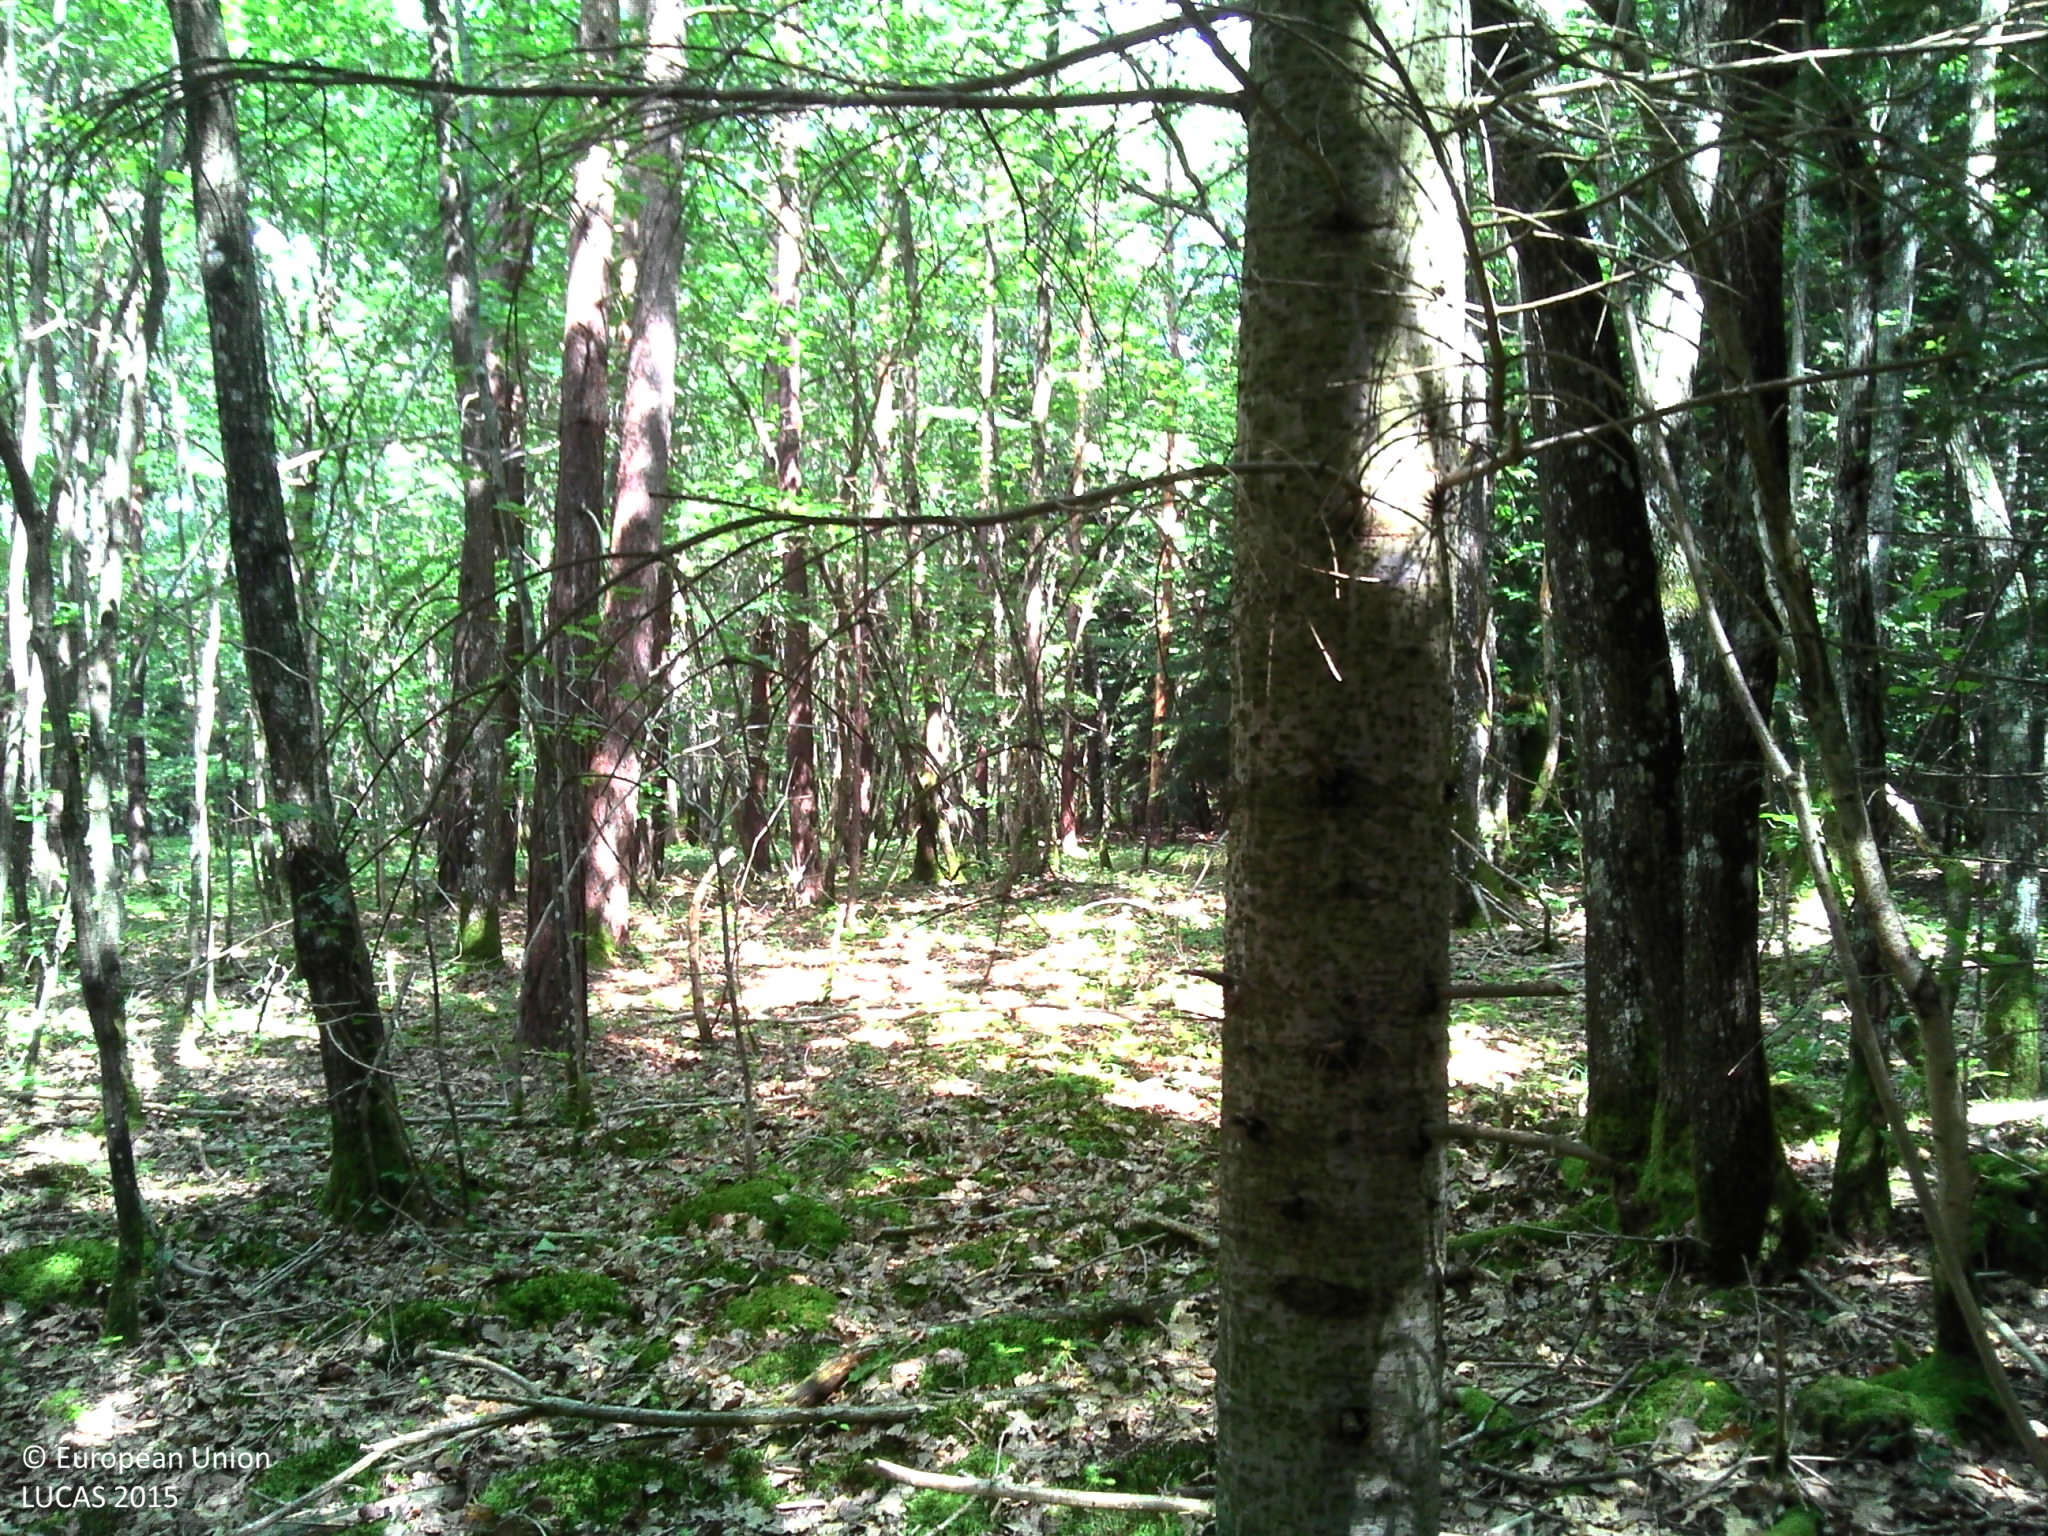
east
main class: Woodland
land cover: Spruce dominated mixed woodland
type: acidophilous oak and oak-birch forest
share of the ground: > 75 %
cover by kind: broadleaved forest trees 70 %, coniferous forest trees 25 %, lichens and mosses 5 %
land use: Forestry
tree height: > 5 m
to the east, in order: Spruce dominated mixed woodland; Ditches and canals; Common wheat
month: June
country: FR
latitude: 46.1429
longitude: 3.0465
